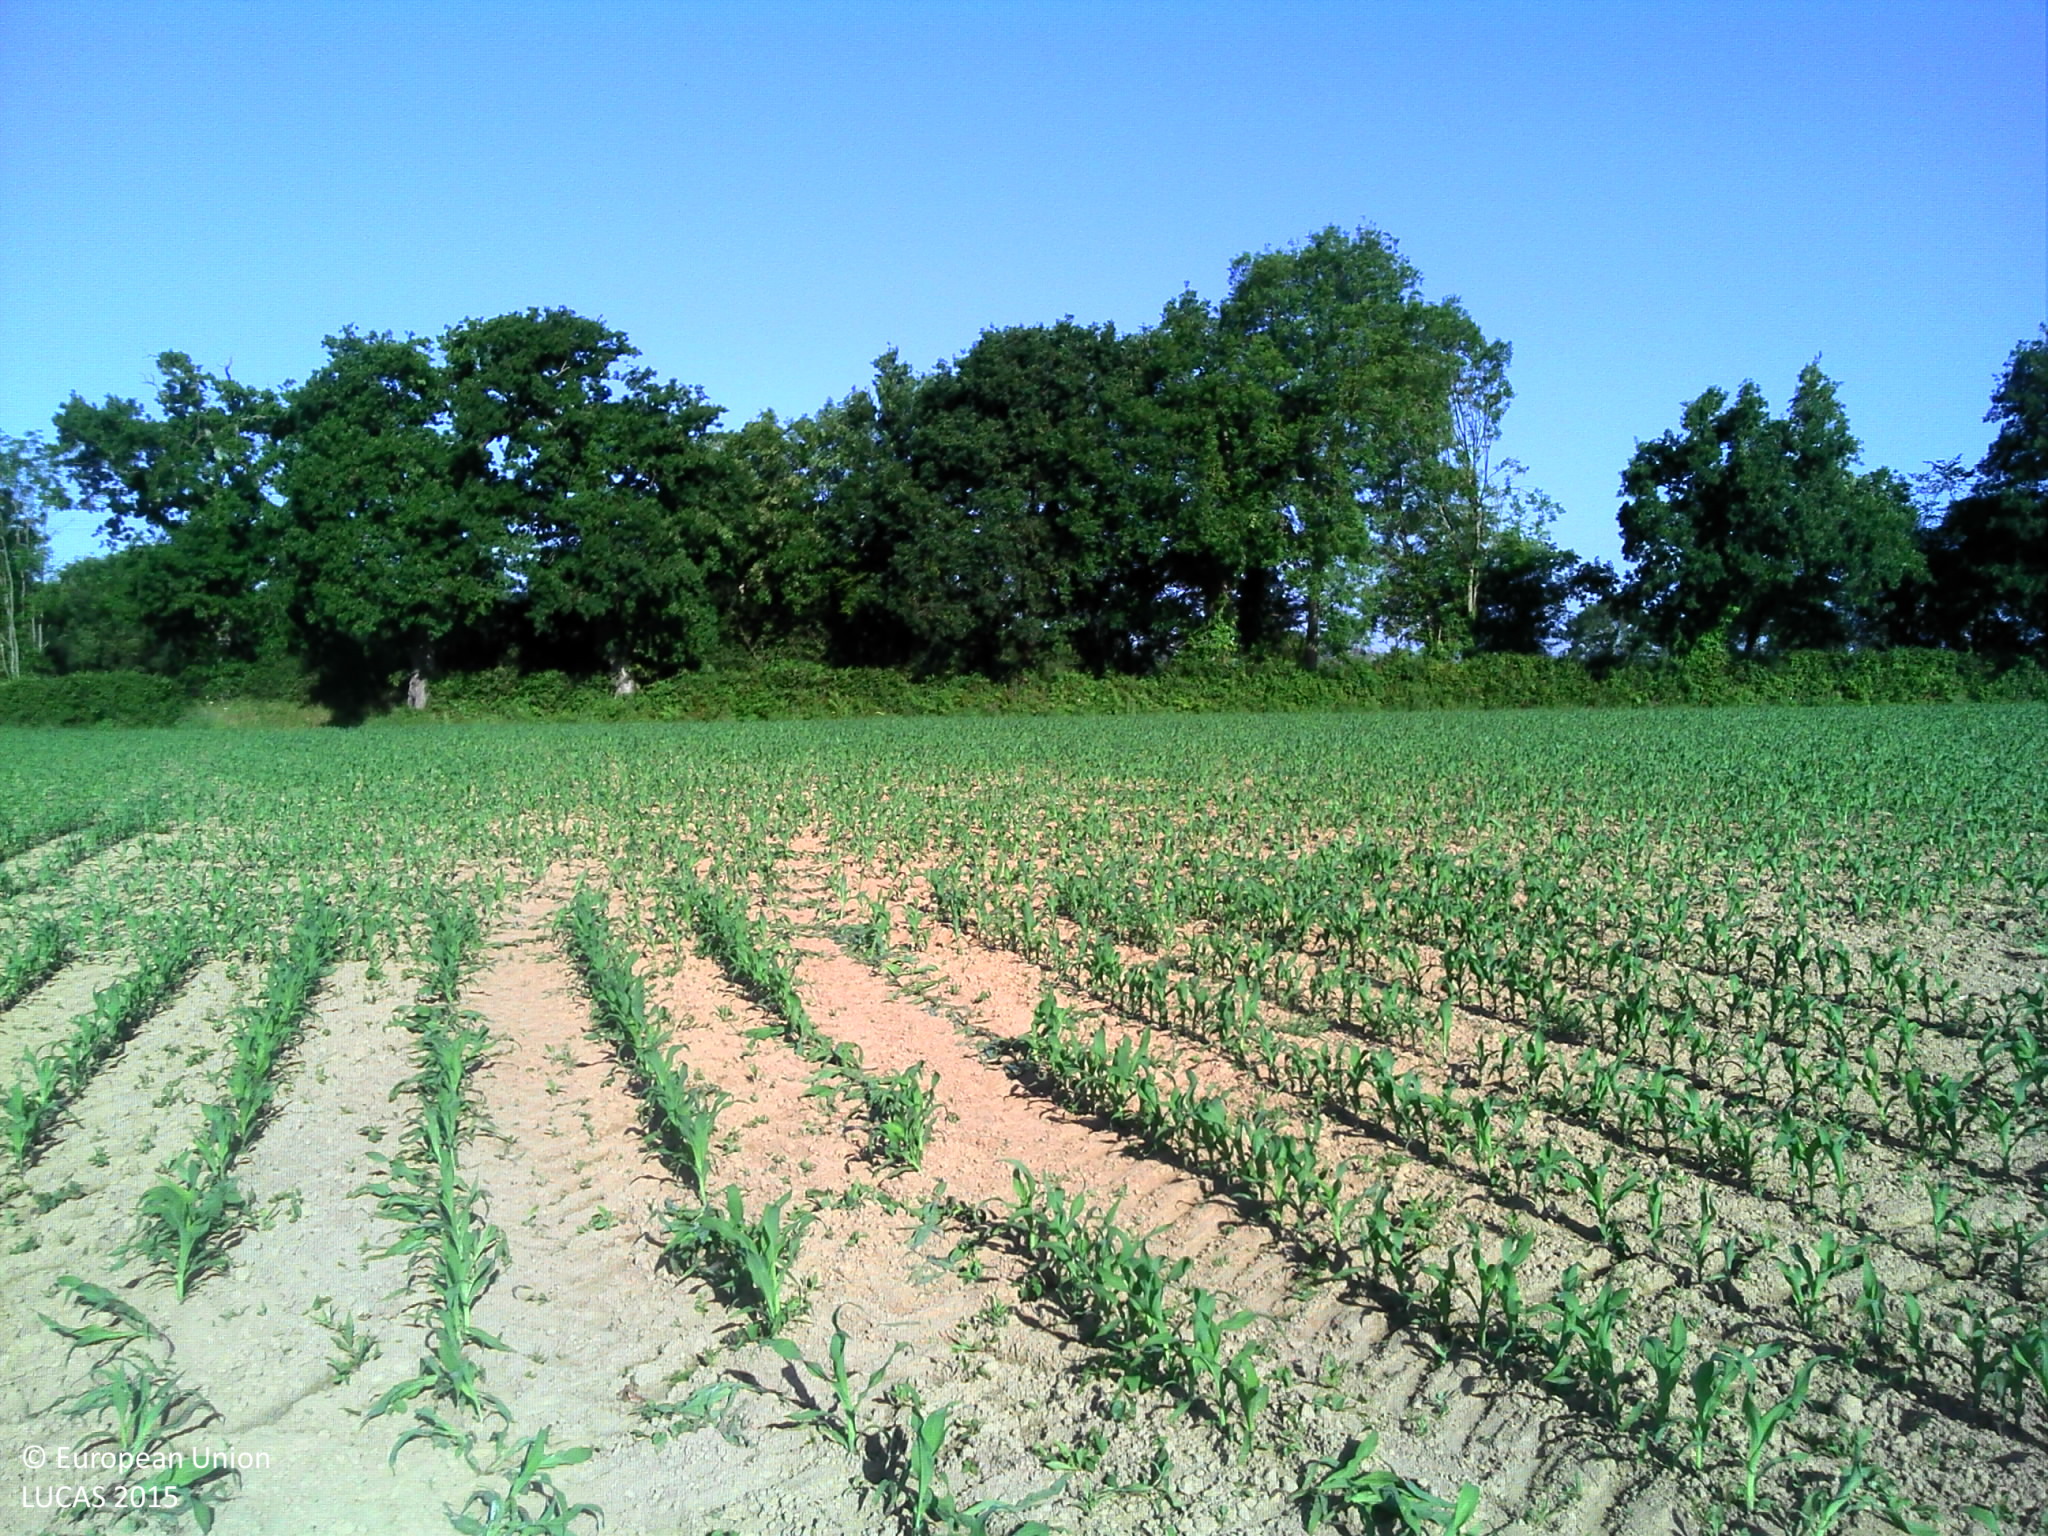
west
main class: Cropland
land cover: Maize
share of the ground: 10 - 25 %
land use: Agriculture (excluding fallow land and kitchen gardens)
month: June
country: FR
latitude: 49.3293
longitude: -1.4835
